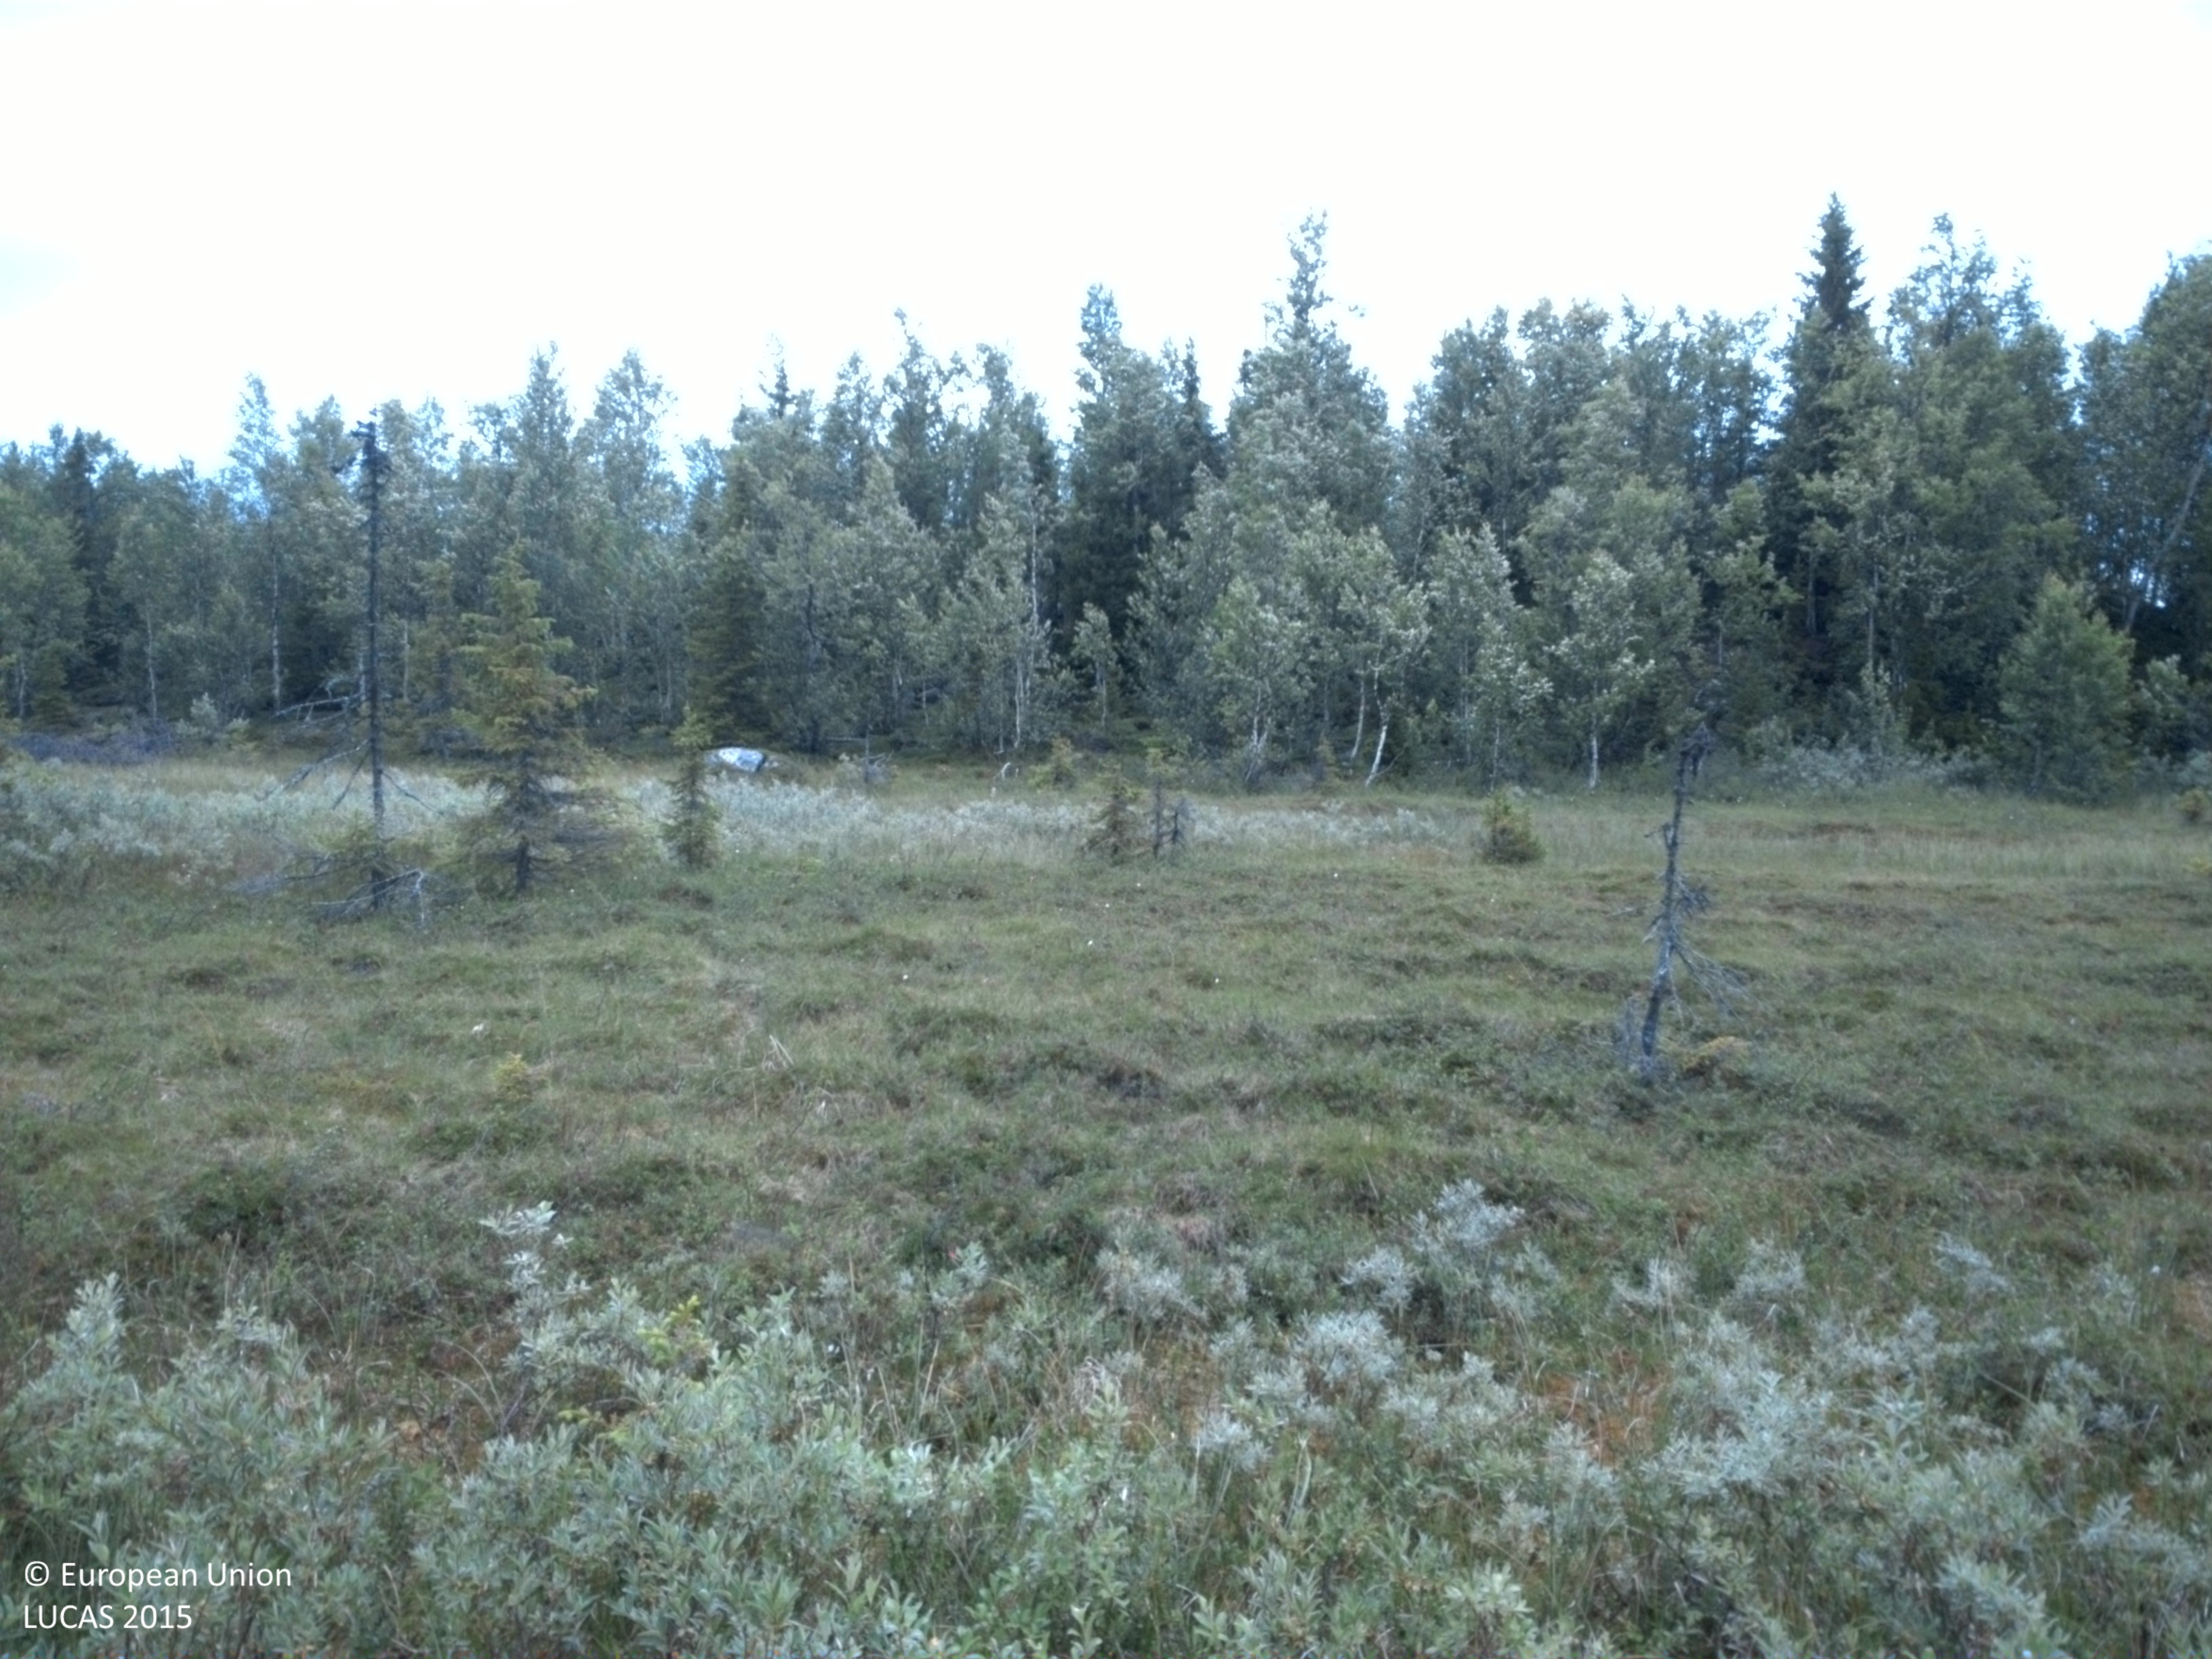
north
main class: Shrubland
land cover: Shrubland with sparse tree cover
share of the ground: > 75 %
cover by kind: shrubs 75 %, herbaceous plants 10 %, lichens and mosses 10 %, coniferous forest trees 5 %
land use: Semi-natural and natural areas not in use
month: August
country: SE
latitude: 64.9909
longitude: 15.5005
